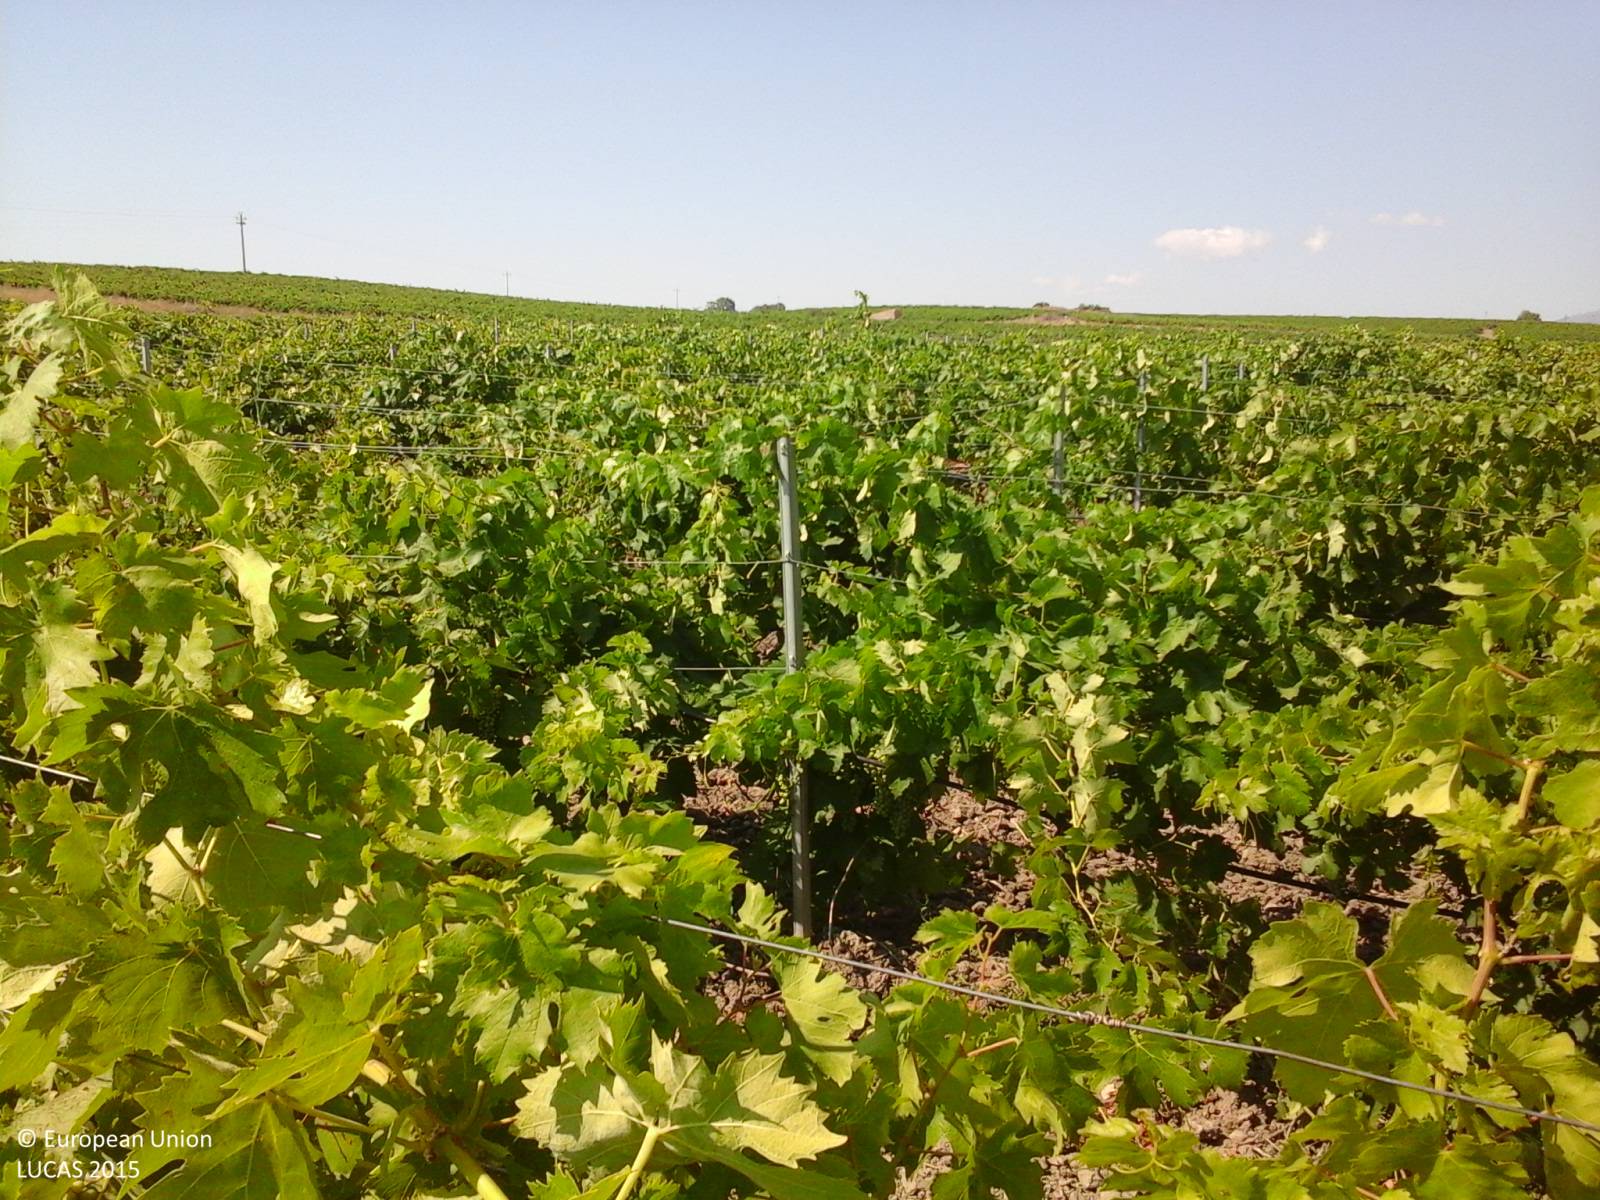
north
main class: Cropland
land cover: Vineyards
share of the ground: 50 - 75 %
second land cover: Other bare soil
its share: > 75 %
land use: Agriculture (excluding fallow land and kitchen gardens)
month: July
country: IT
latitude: 37.7833
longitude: 12.6485
